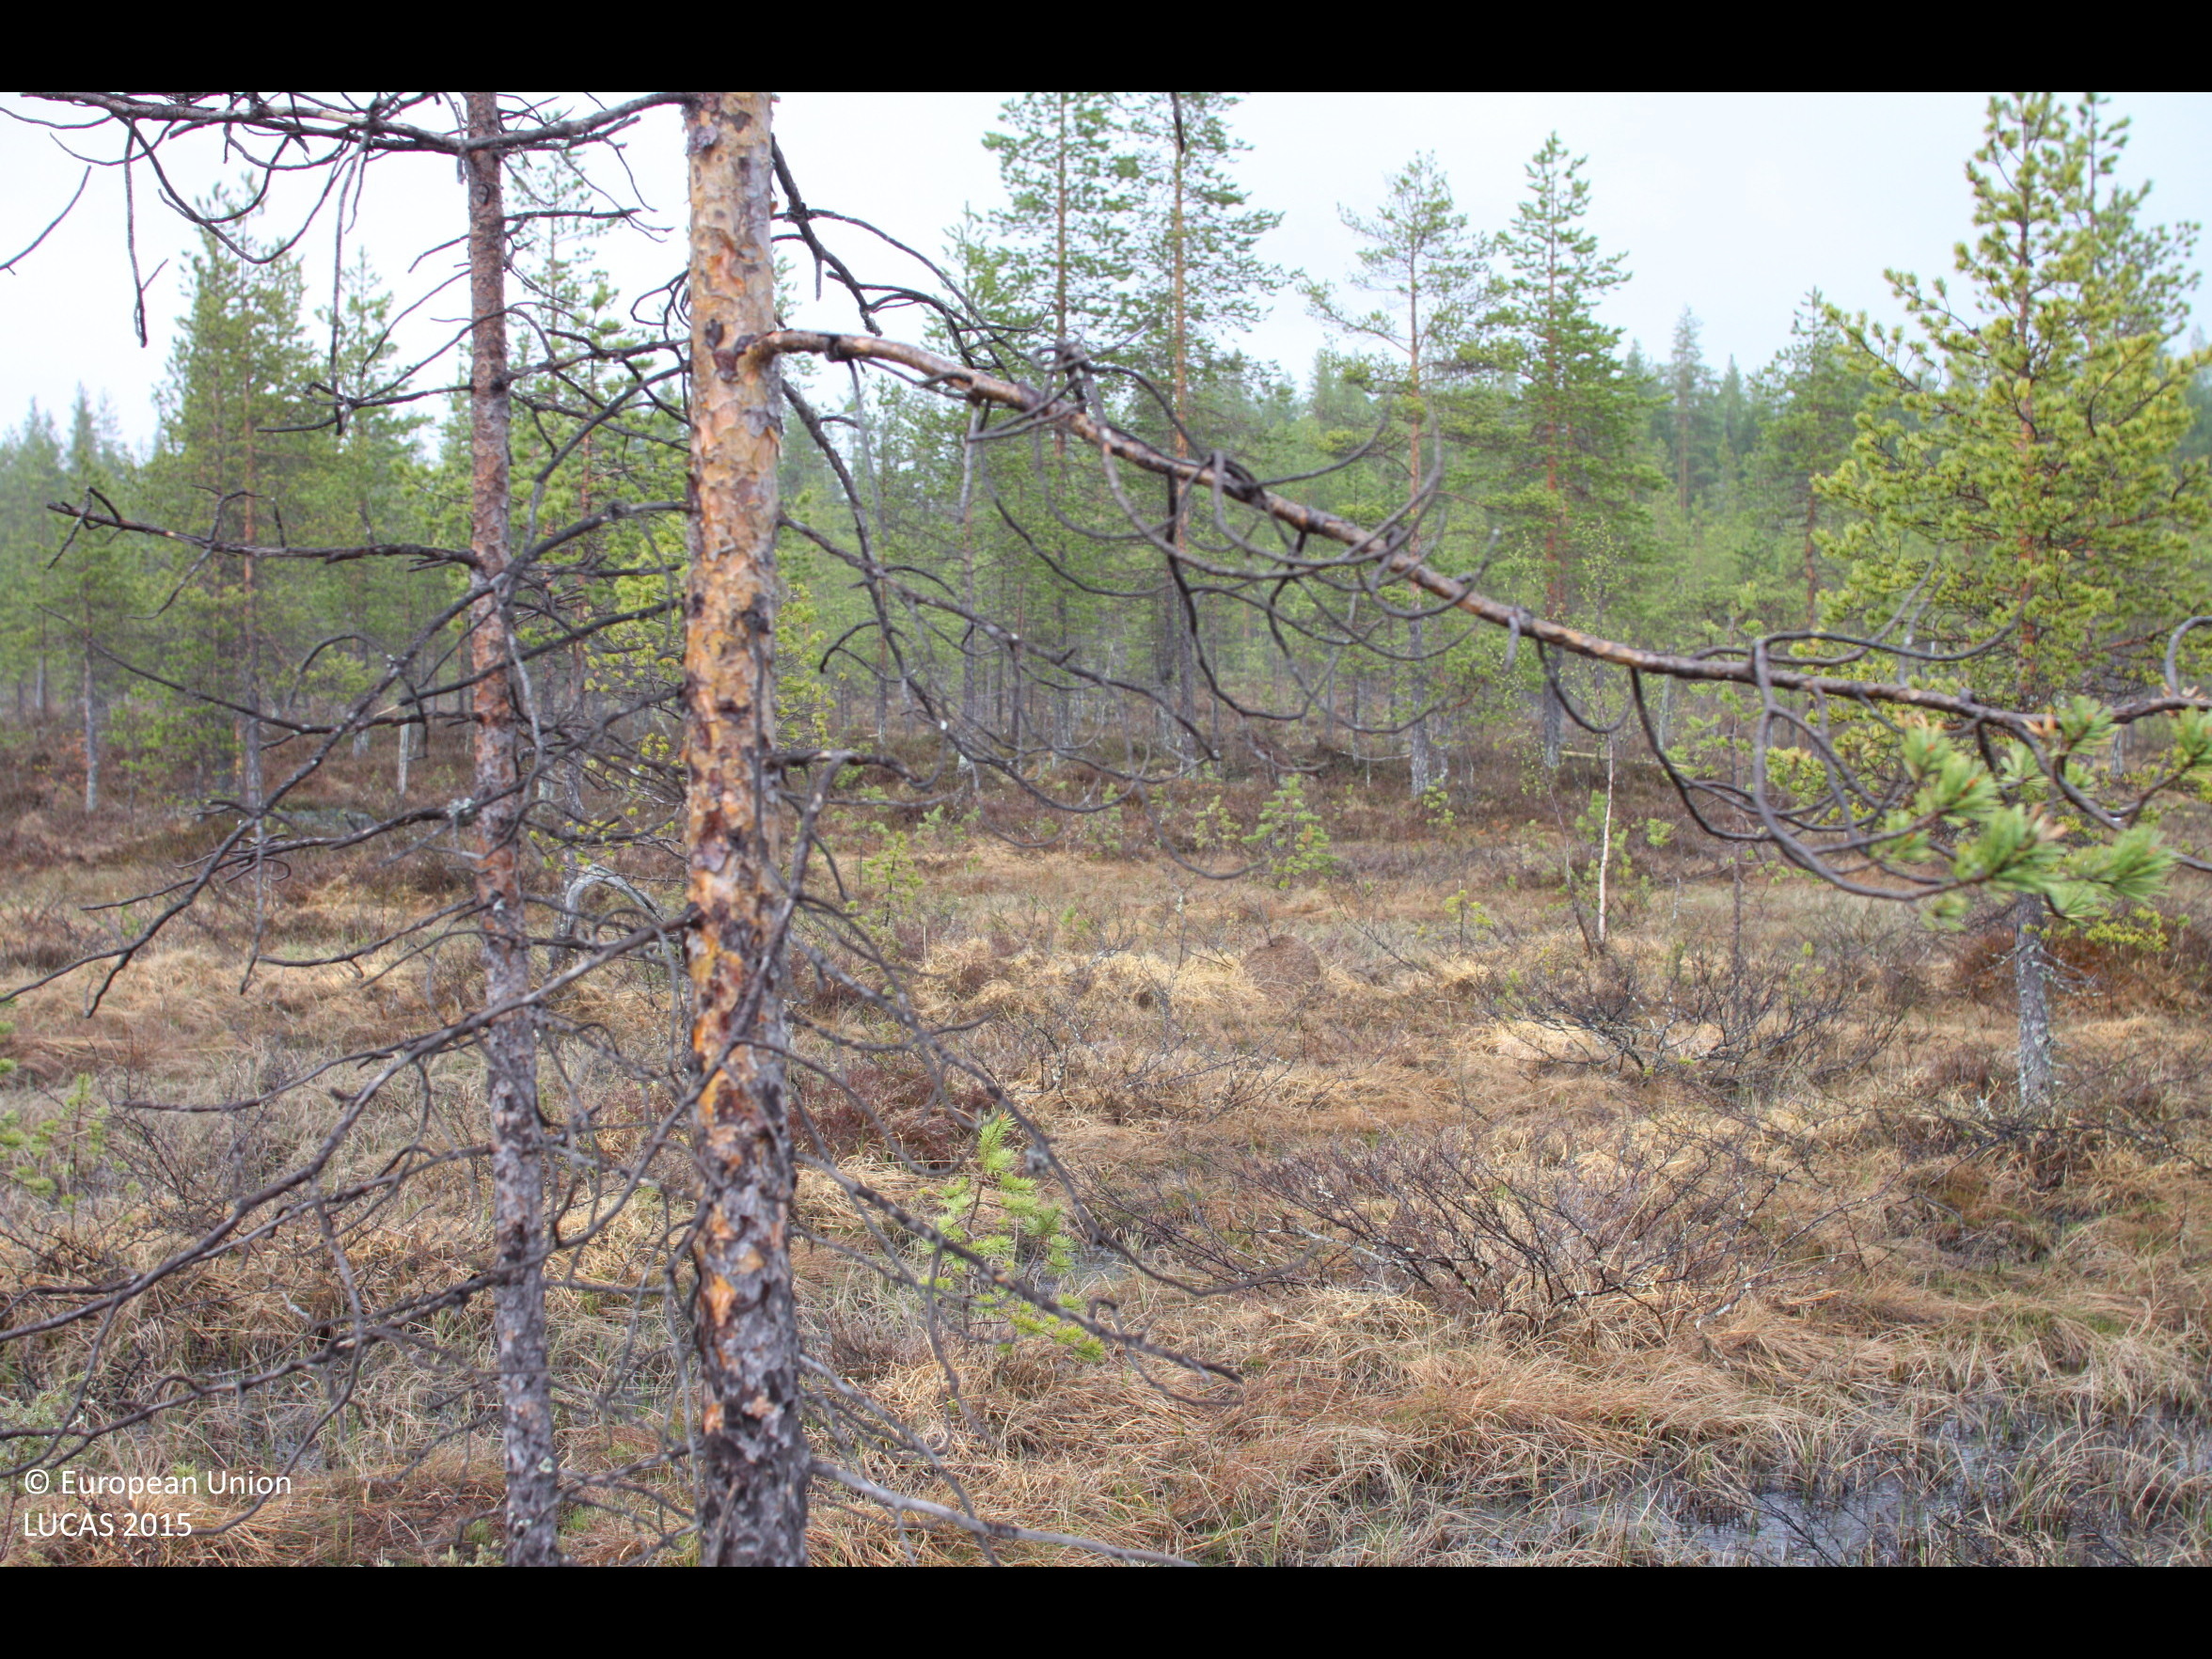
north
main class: Woodland
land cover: Pine dominated coniferous woodland
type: mire and swamp forests
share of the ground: 25 - 50 %
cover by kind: herbaceous plants 30 %, coniferous forest trees 25 %, lichens and mosses 25 %, shrubs 20 %
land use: Forestry
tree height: > 5 m
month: June
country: FI
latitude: 66.2768
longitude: 28.2506
